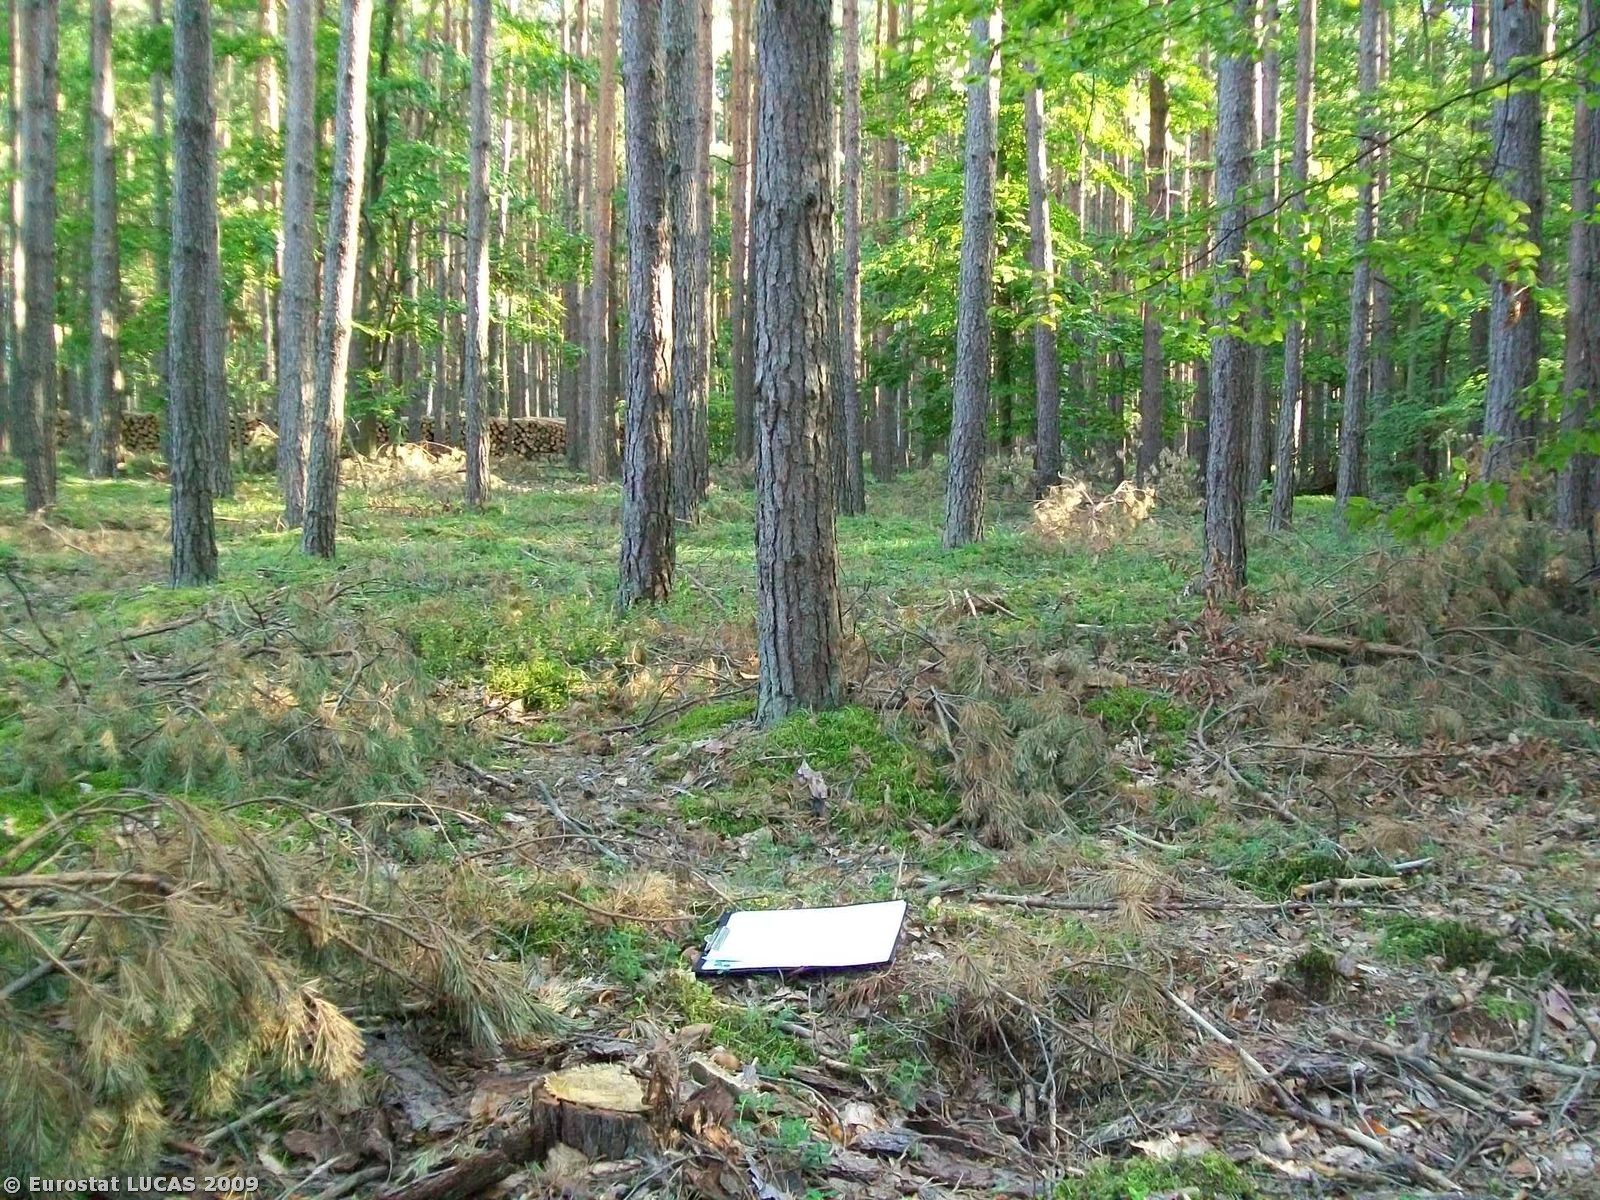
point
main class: Woodland
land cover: Mixed woodland
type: hemiboreal forest and nemoral coniferous forest and mixed broadleaved-coniferous forest
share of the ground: > 75 %
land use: Forestry
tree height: > 5 m
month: August
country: PL
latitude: 51.0294
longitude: 17.6421
